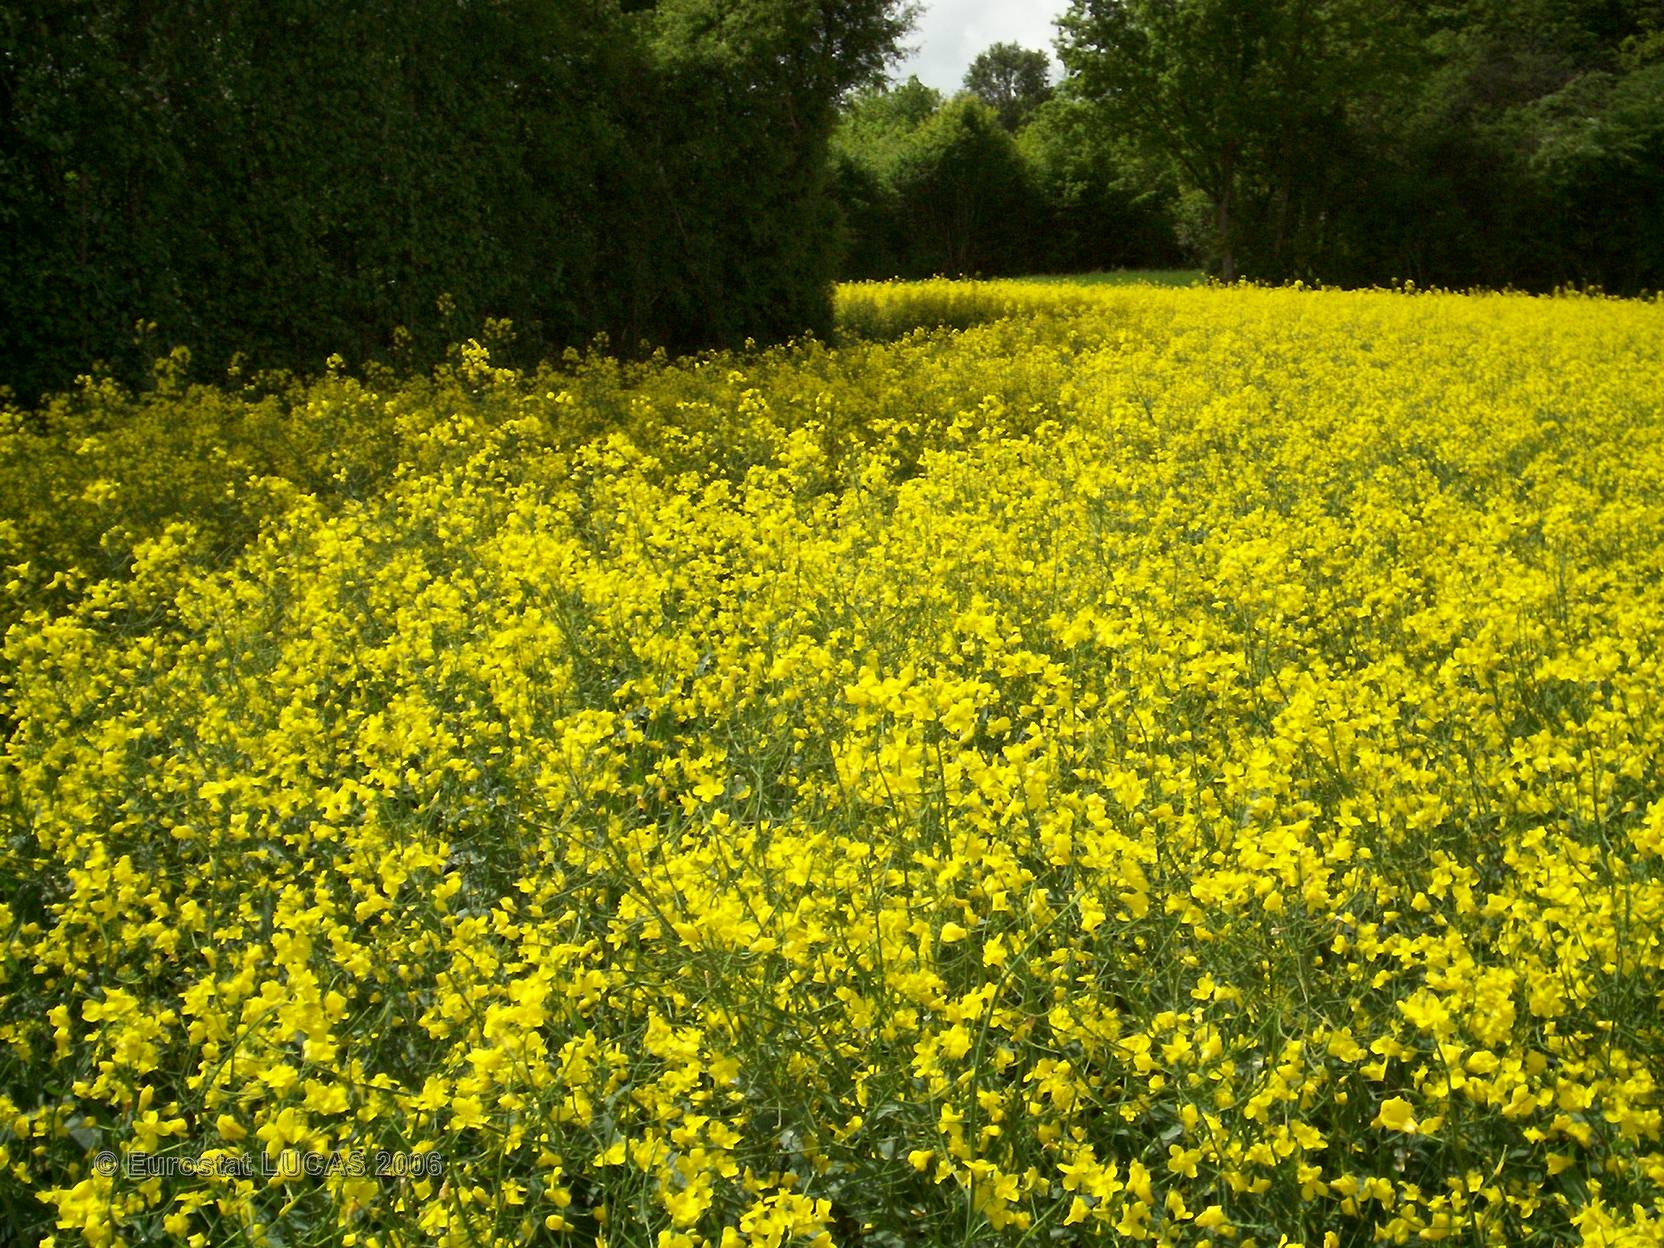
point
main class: Cropland
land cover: Rape and turnip rape
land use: Agriculture (excluding fallow land and kitchen gardens)
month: May
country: FR
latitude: 47.0664
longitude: 4.6676
